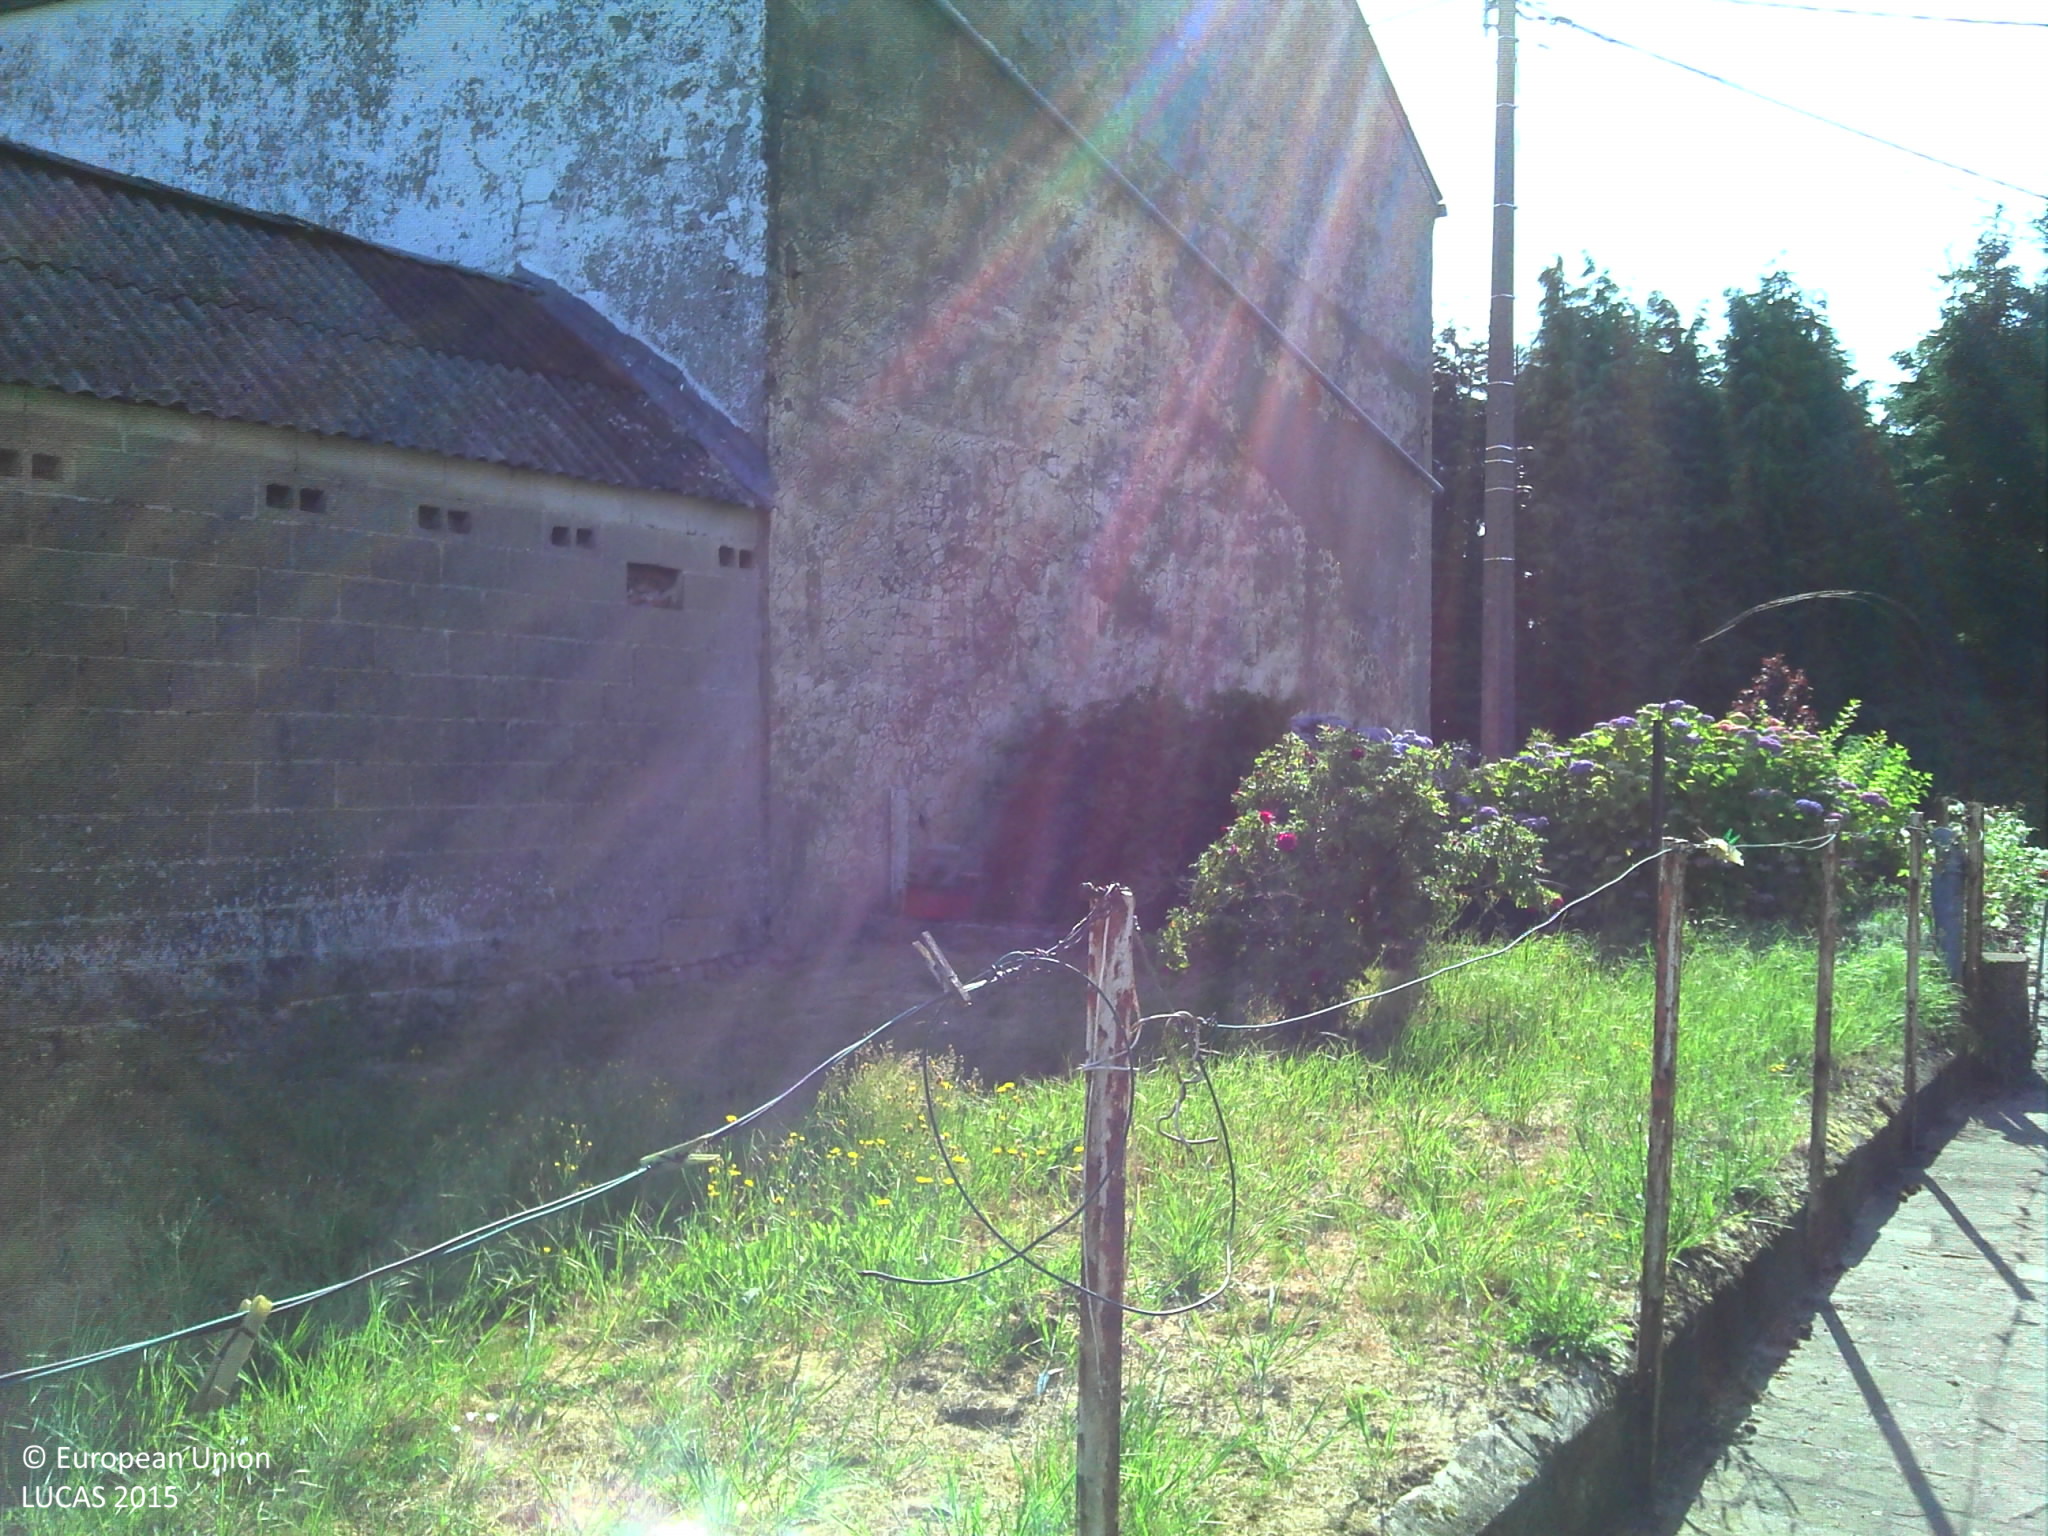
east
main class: Grassland
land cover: Grassland with sparse tree/shrub cover
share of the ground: > 75 %
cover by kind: herbaceous plants 95 %, broadleaved forest trees 5 %
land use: Residential
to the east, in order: Grassland with sparse tree/shrub cover; Artificial constructions in urban areas; Grassland without tree/shrub cover; Fences; Grassland without tree/shrub cover; Fences; Grassland without tree/shrub cover; Fences; Single bushes/trees; Fences; Grassland without tree/shrub cover
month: July
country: BE
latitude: 50.2916
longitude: 4.6203
